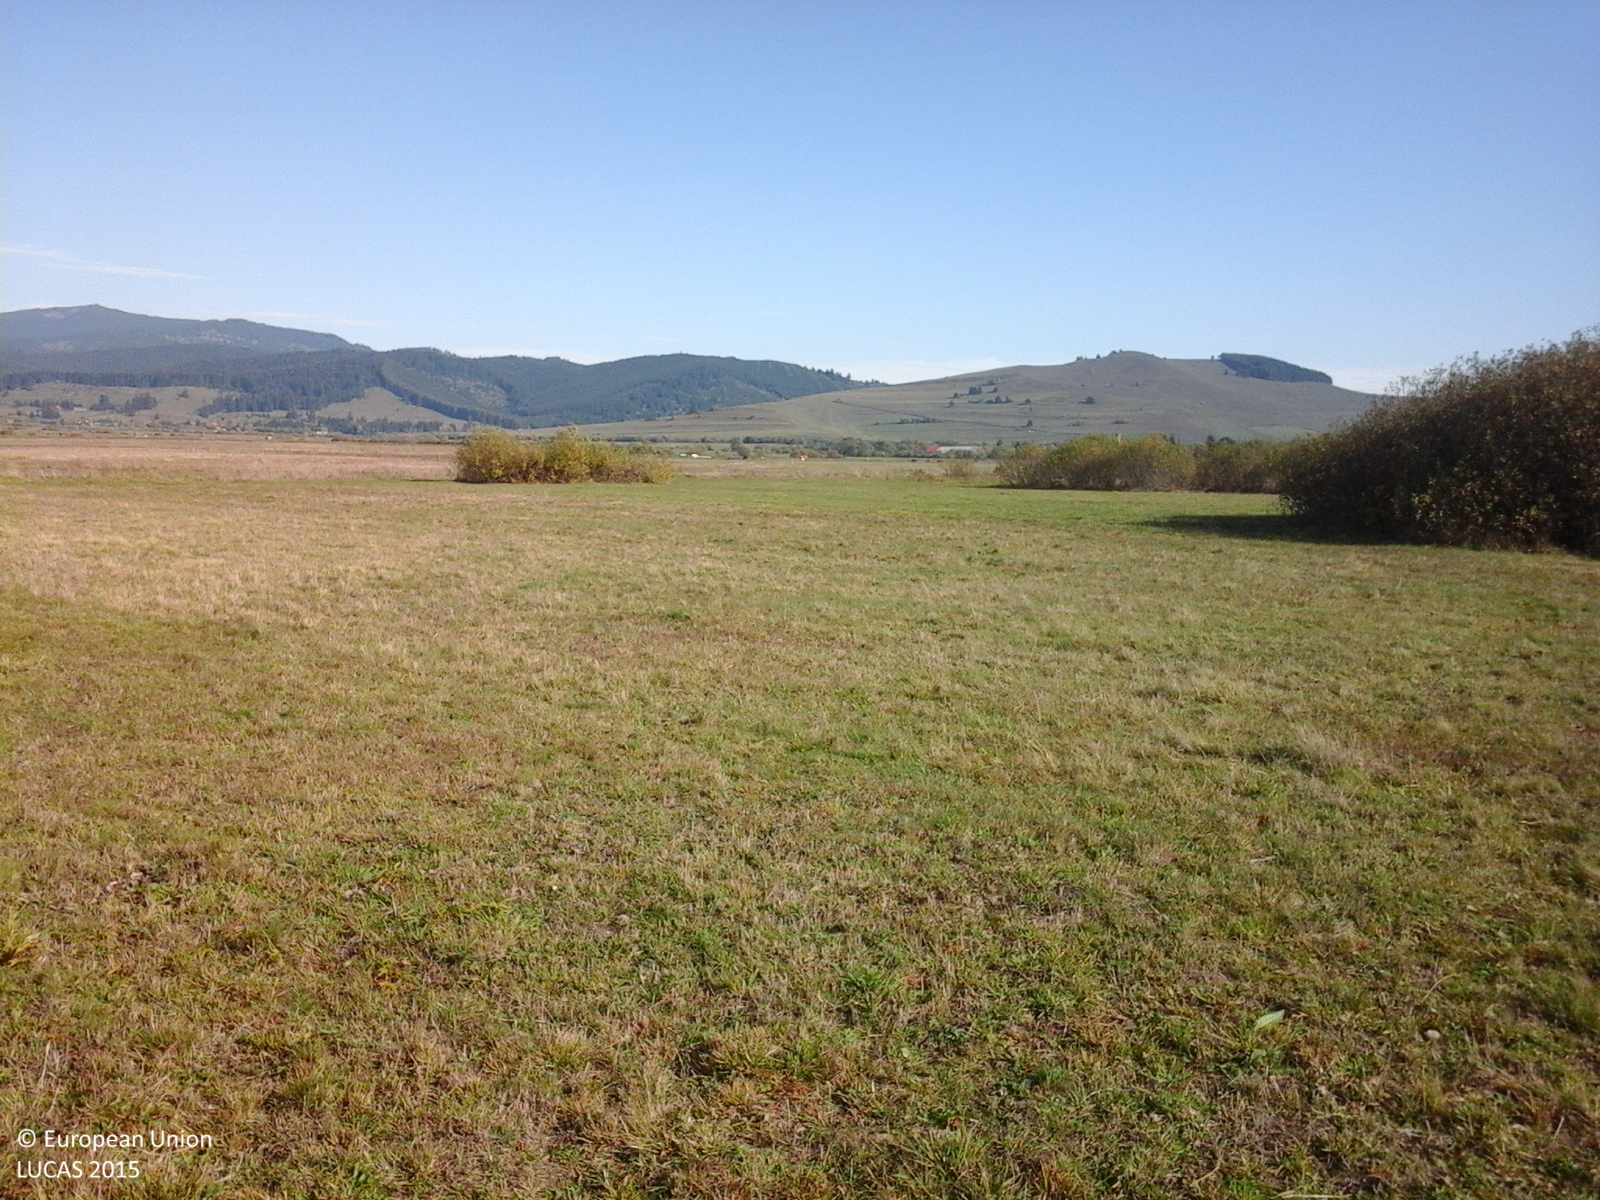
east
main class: Grassland
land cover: Grassland without tree/shrub cover
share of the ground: > 75 %
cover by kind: herbaceous plants 100 %
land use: Agriculture (excluding fallow land and kitchen gardens)
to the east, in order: Grassland without tree/shrub cover; Electric lines; Grassland without tree/shrub cover; Single bushes/trees; Tracks; Grassland without tree/shrub cover; Fences; Grassland without tree/shrub cover
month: October
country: RO
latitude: 46.7707
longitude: 25.4978
